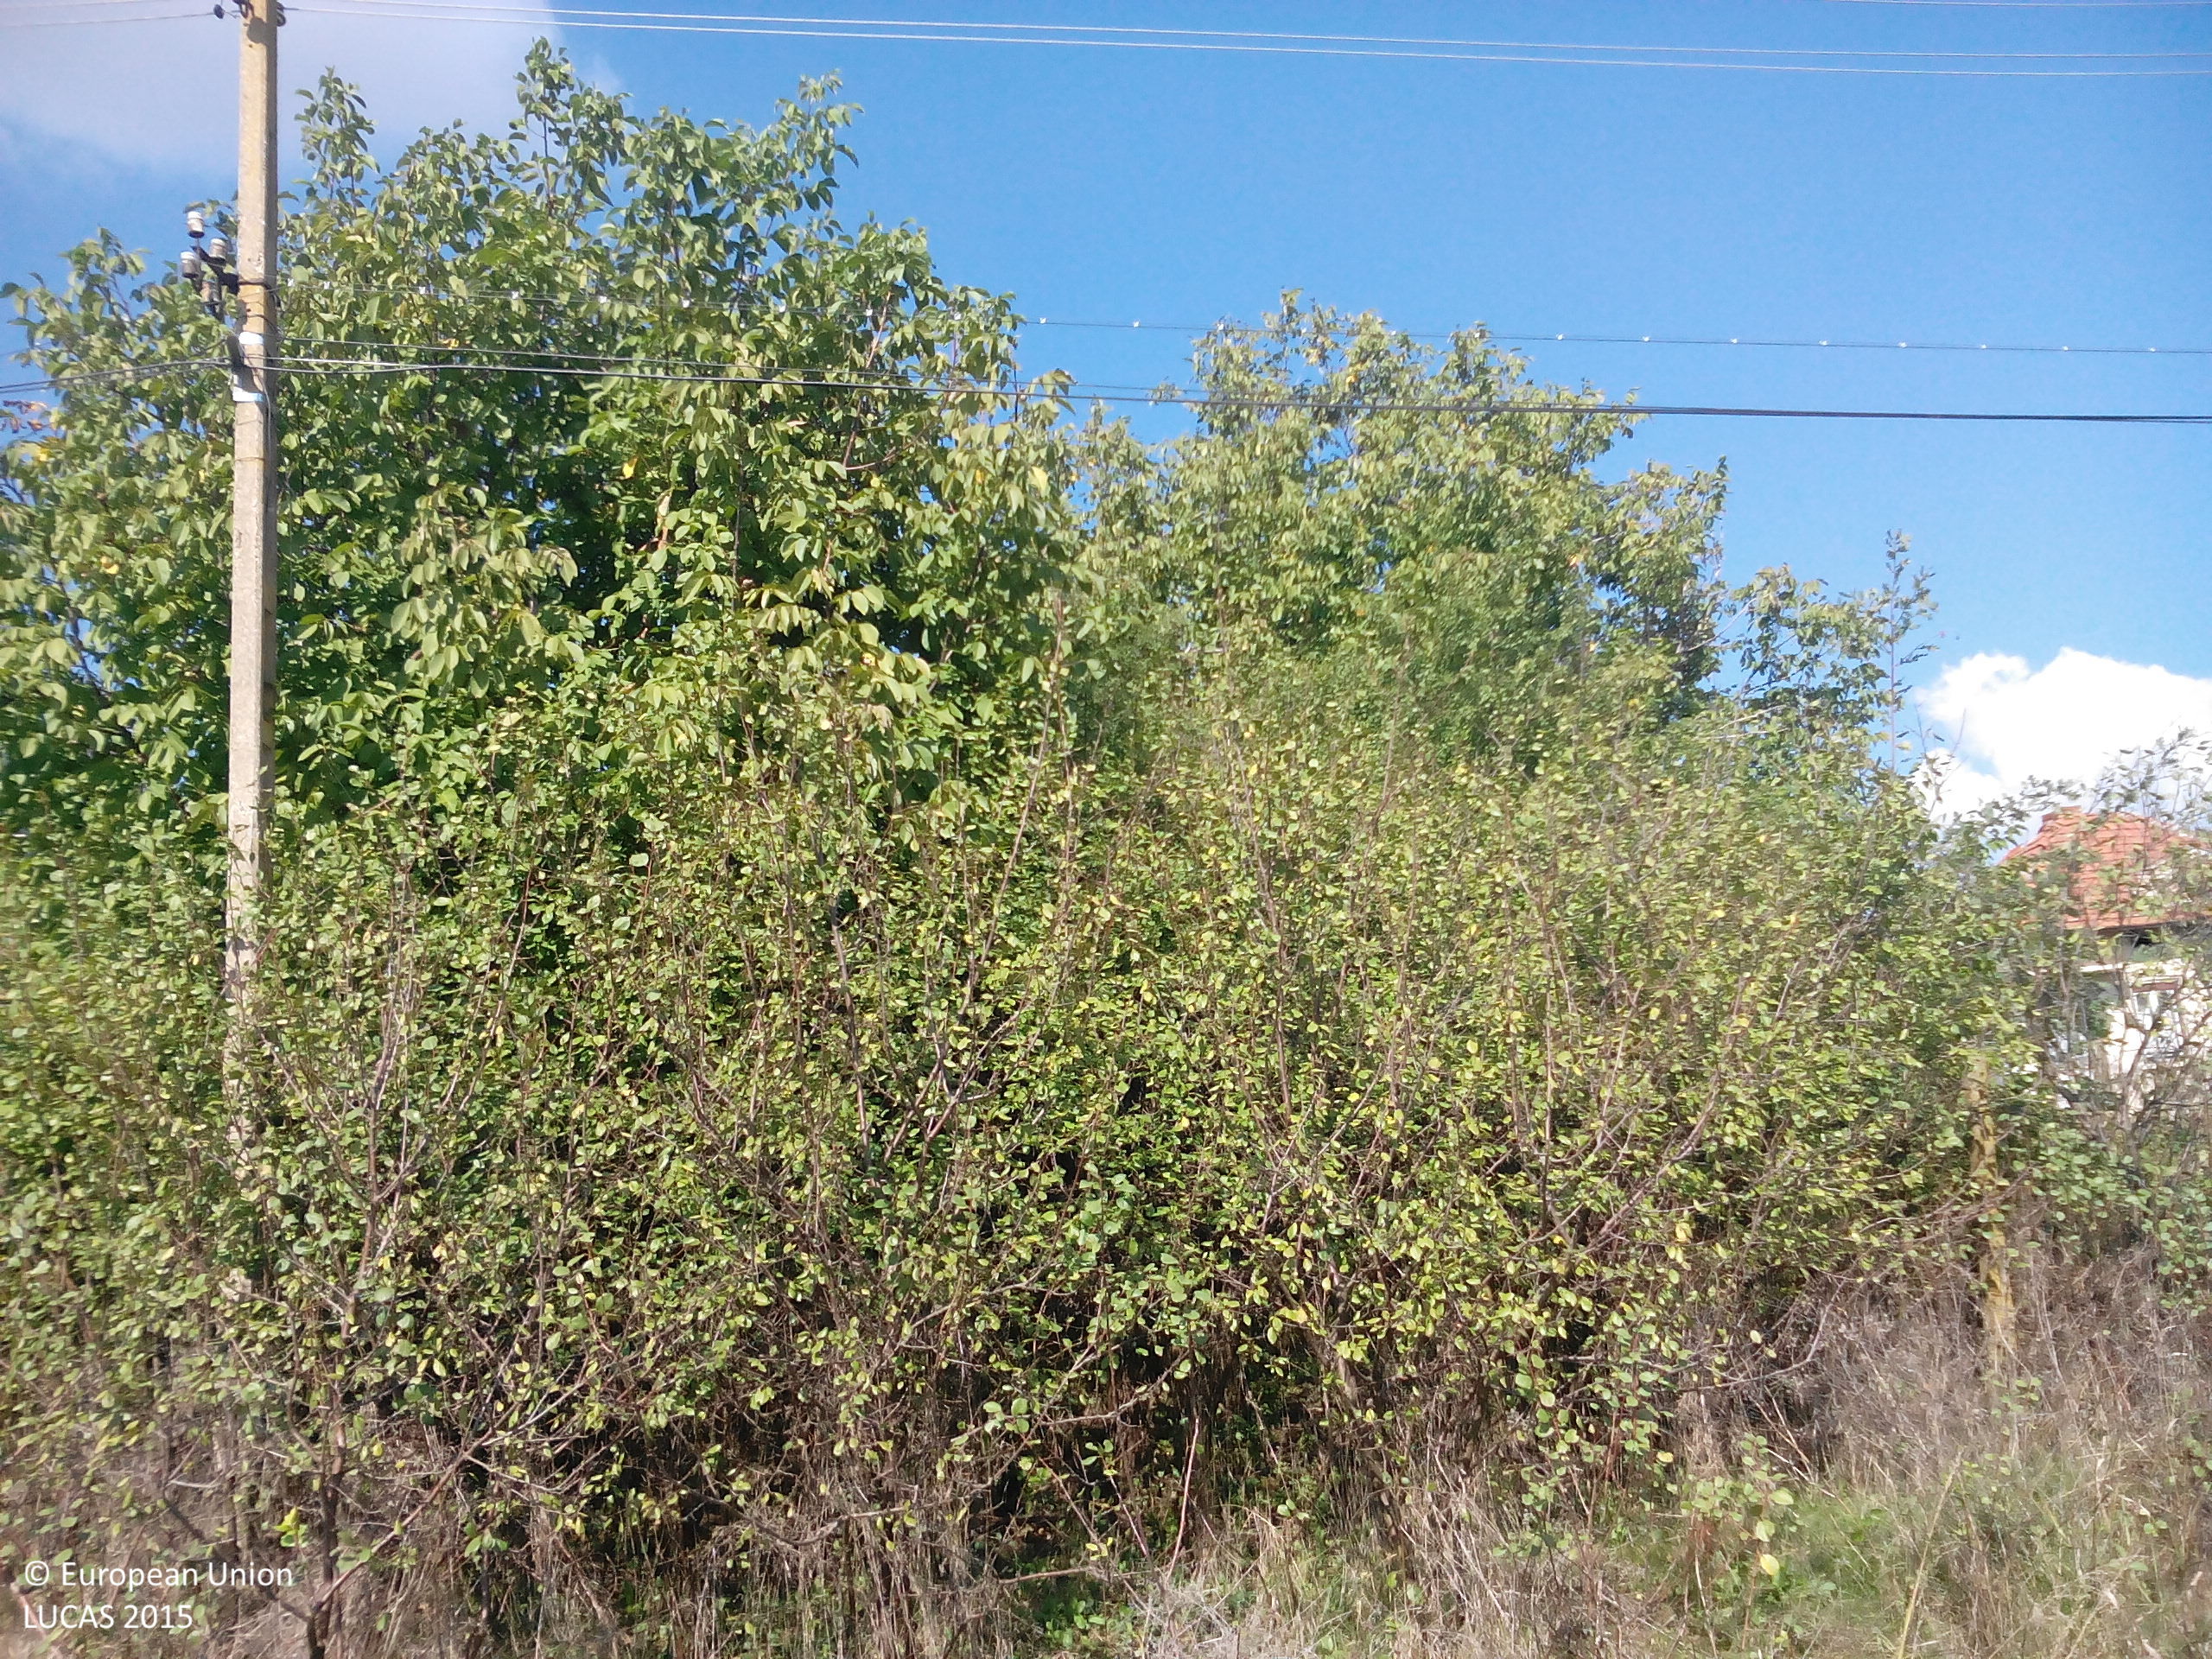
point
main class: Woodland
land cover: Broadleaved woodland
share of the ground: > 75 %
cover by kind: broadleaved forest trees 80 %, shrubs 10 %, herbaceous plants 10 %
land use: Abandoned areas
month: October
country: BG
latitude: 43.4317
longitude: 23.8736
